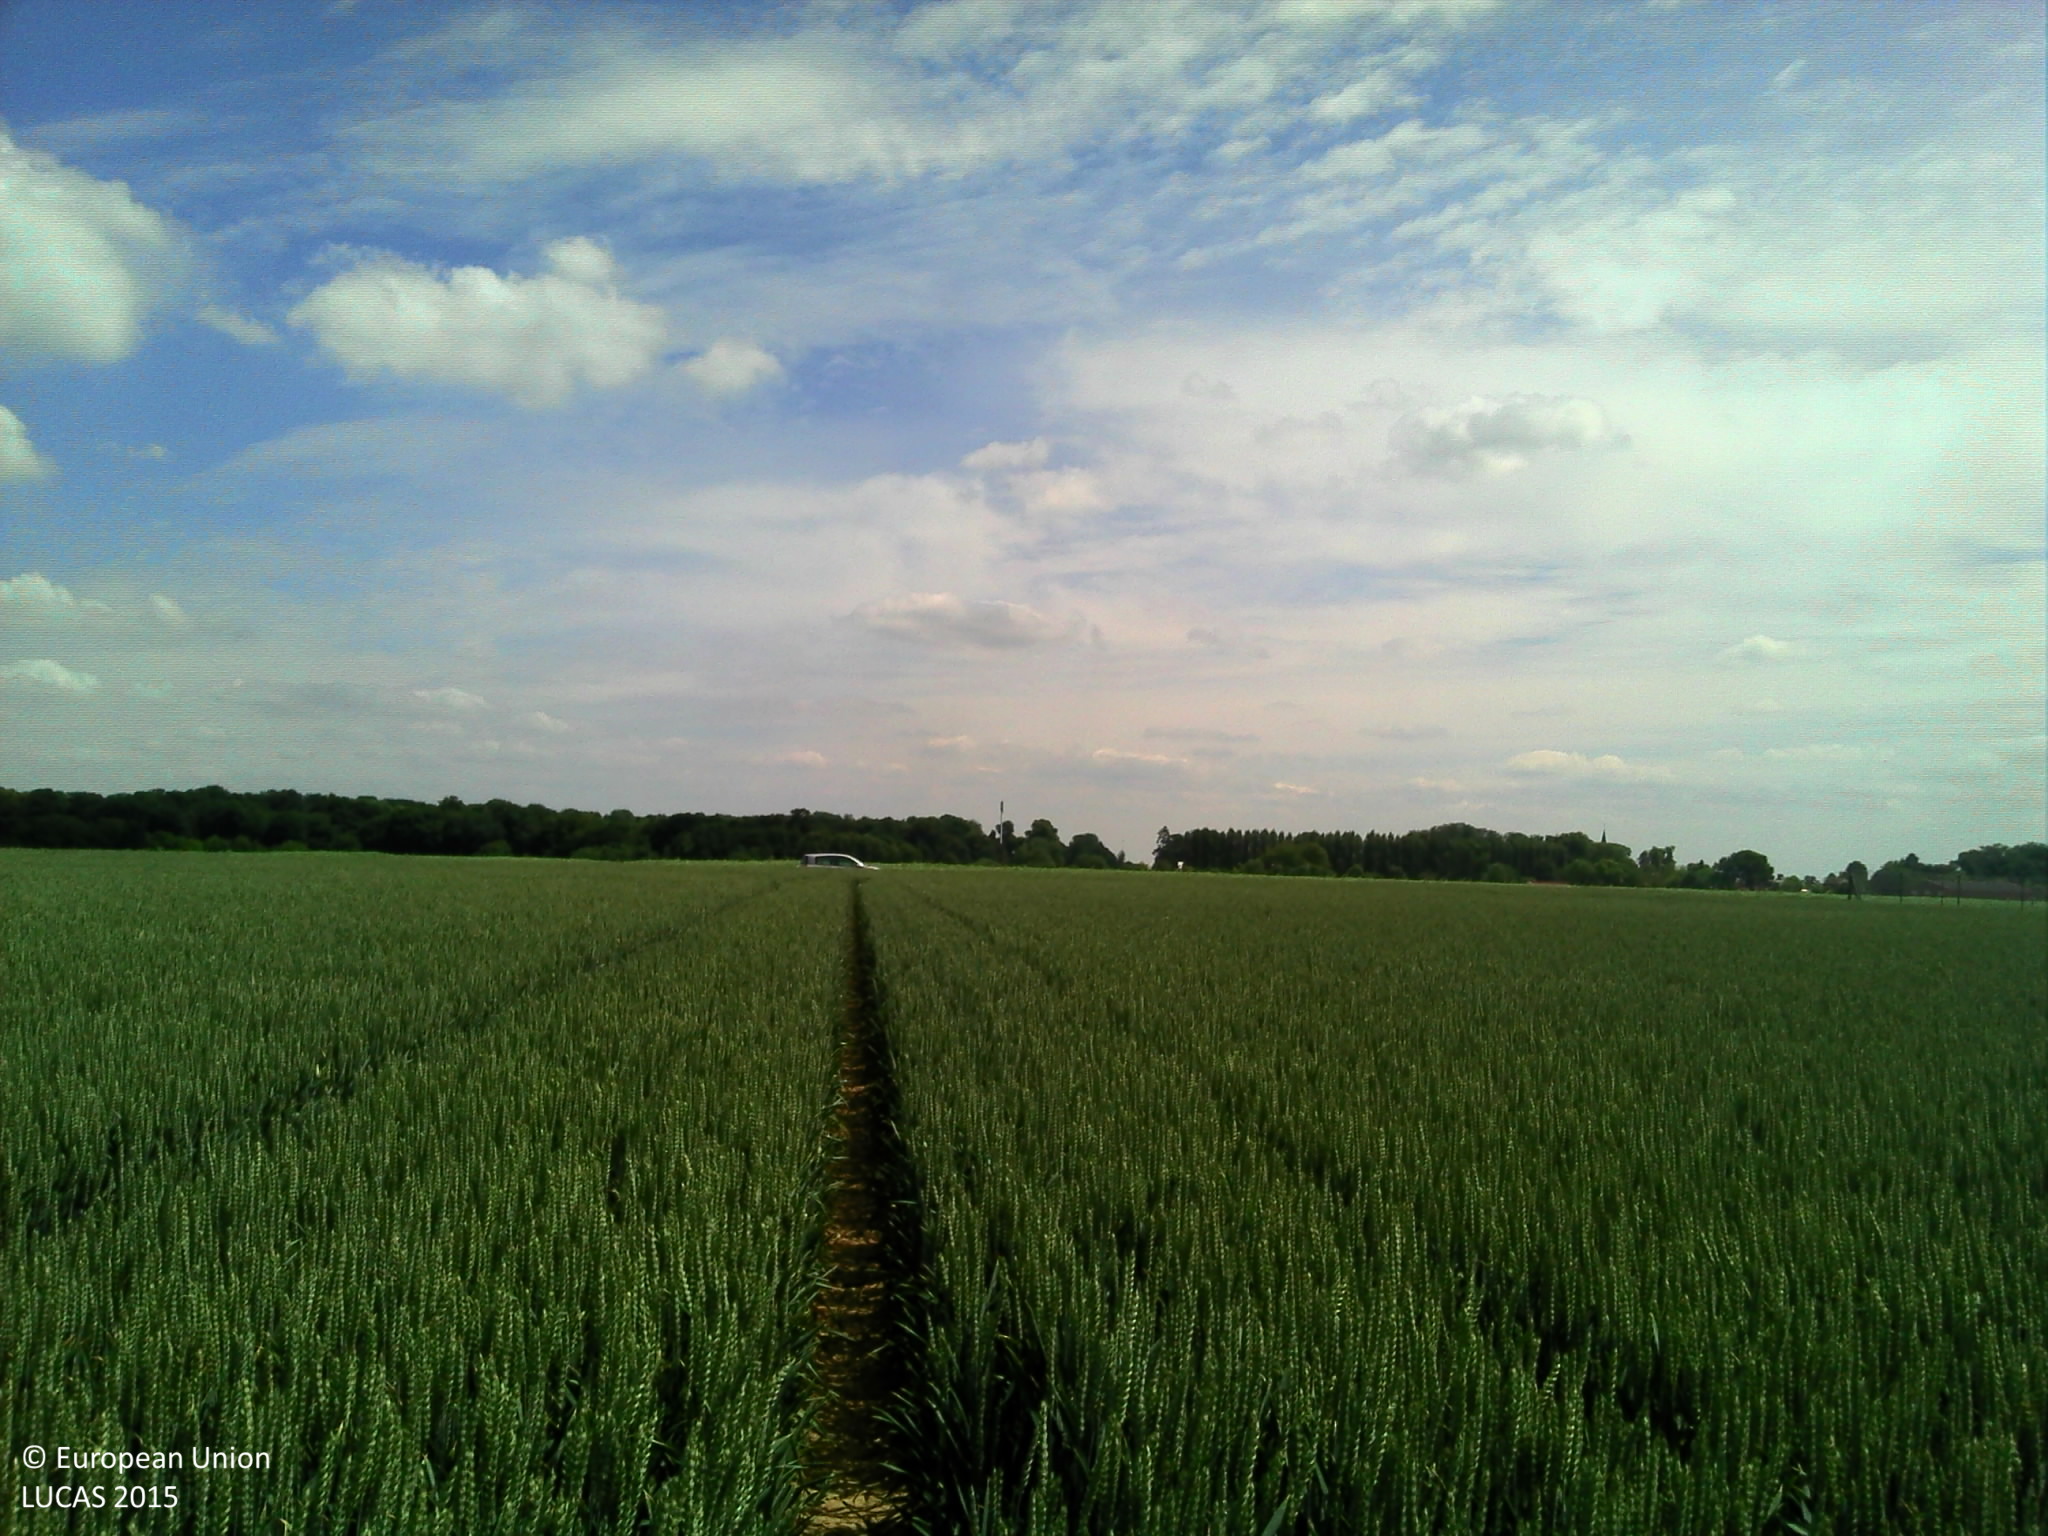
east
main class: Cropland
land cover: Common wheat
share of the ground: > 75 %
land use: Agriculture (excluding fallow land and kitchen gardens)
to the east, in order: Common wheat; Tracks; Grass margins; Dry pulses; Common wheat
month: June
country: FR
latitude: 49.5583
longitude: 2.5089
